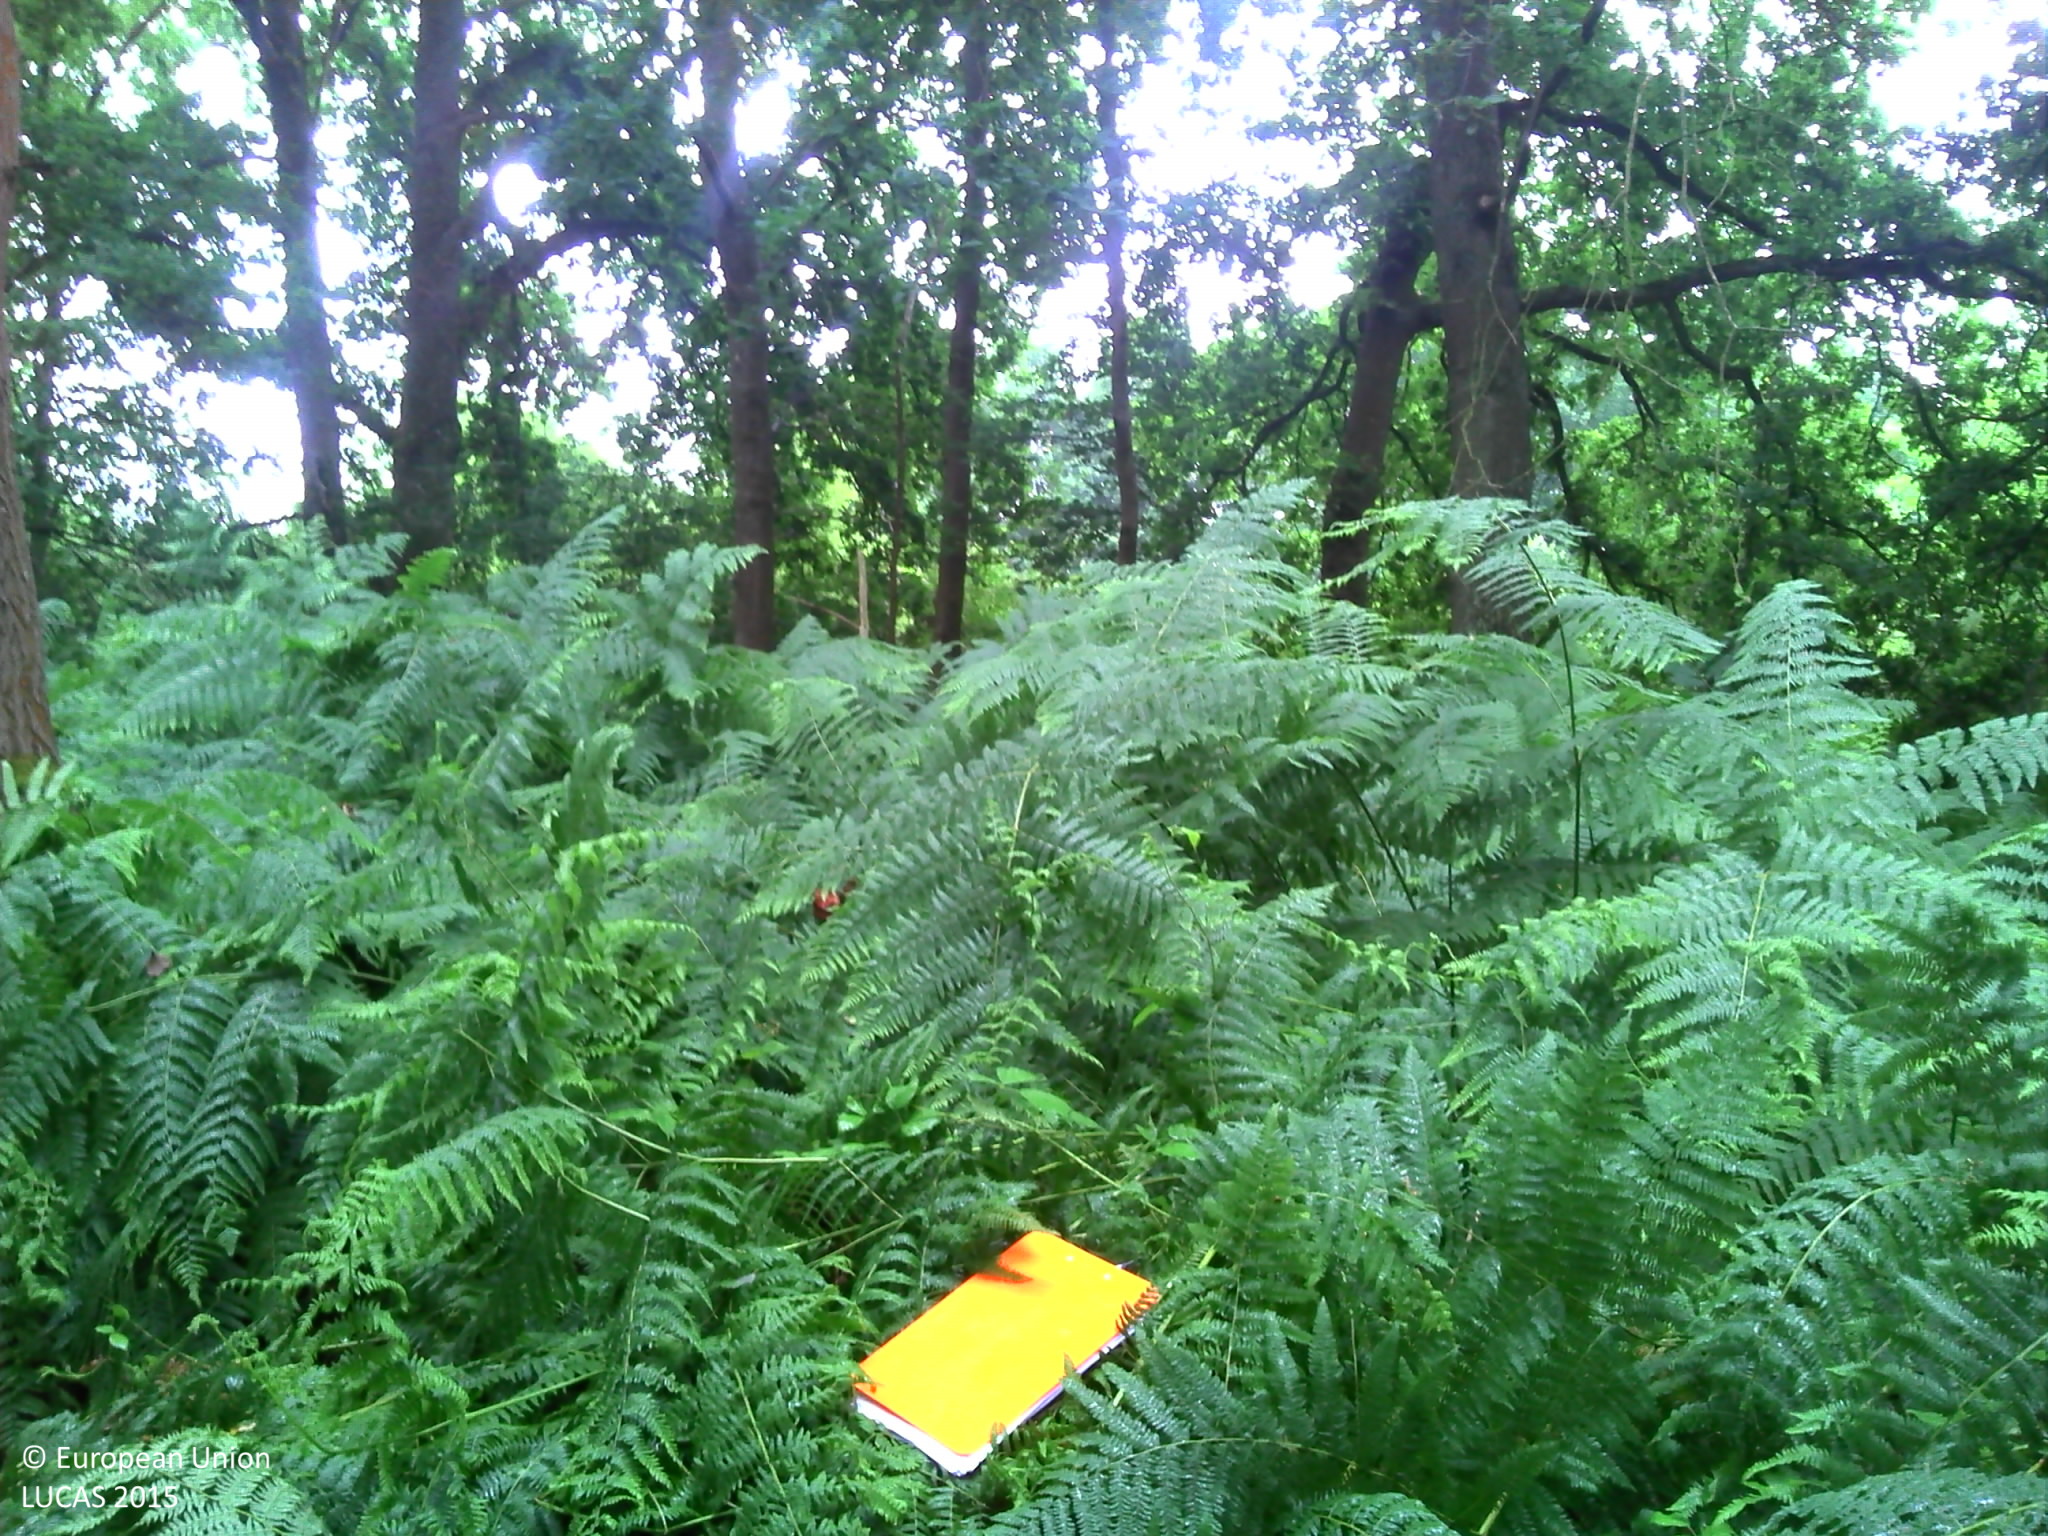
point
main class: Woodland
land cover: Pine dominated mixed woodland
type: mesophytic deciduous forest
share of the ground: > 75 %
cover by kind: broadleaved forest trees 50 %, coniferous forest trees 20 %, herbaceous plants 20 %, consolidated bare surface 10 %
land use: Forestry
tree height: > 5 m
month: July
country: FR
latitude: 49.2224
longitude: 0.6800
